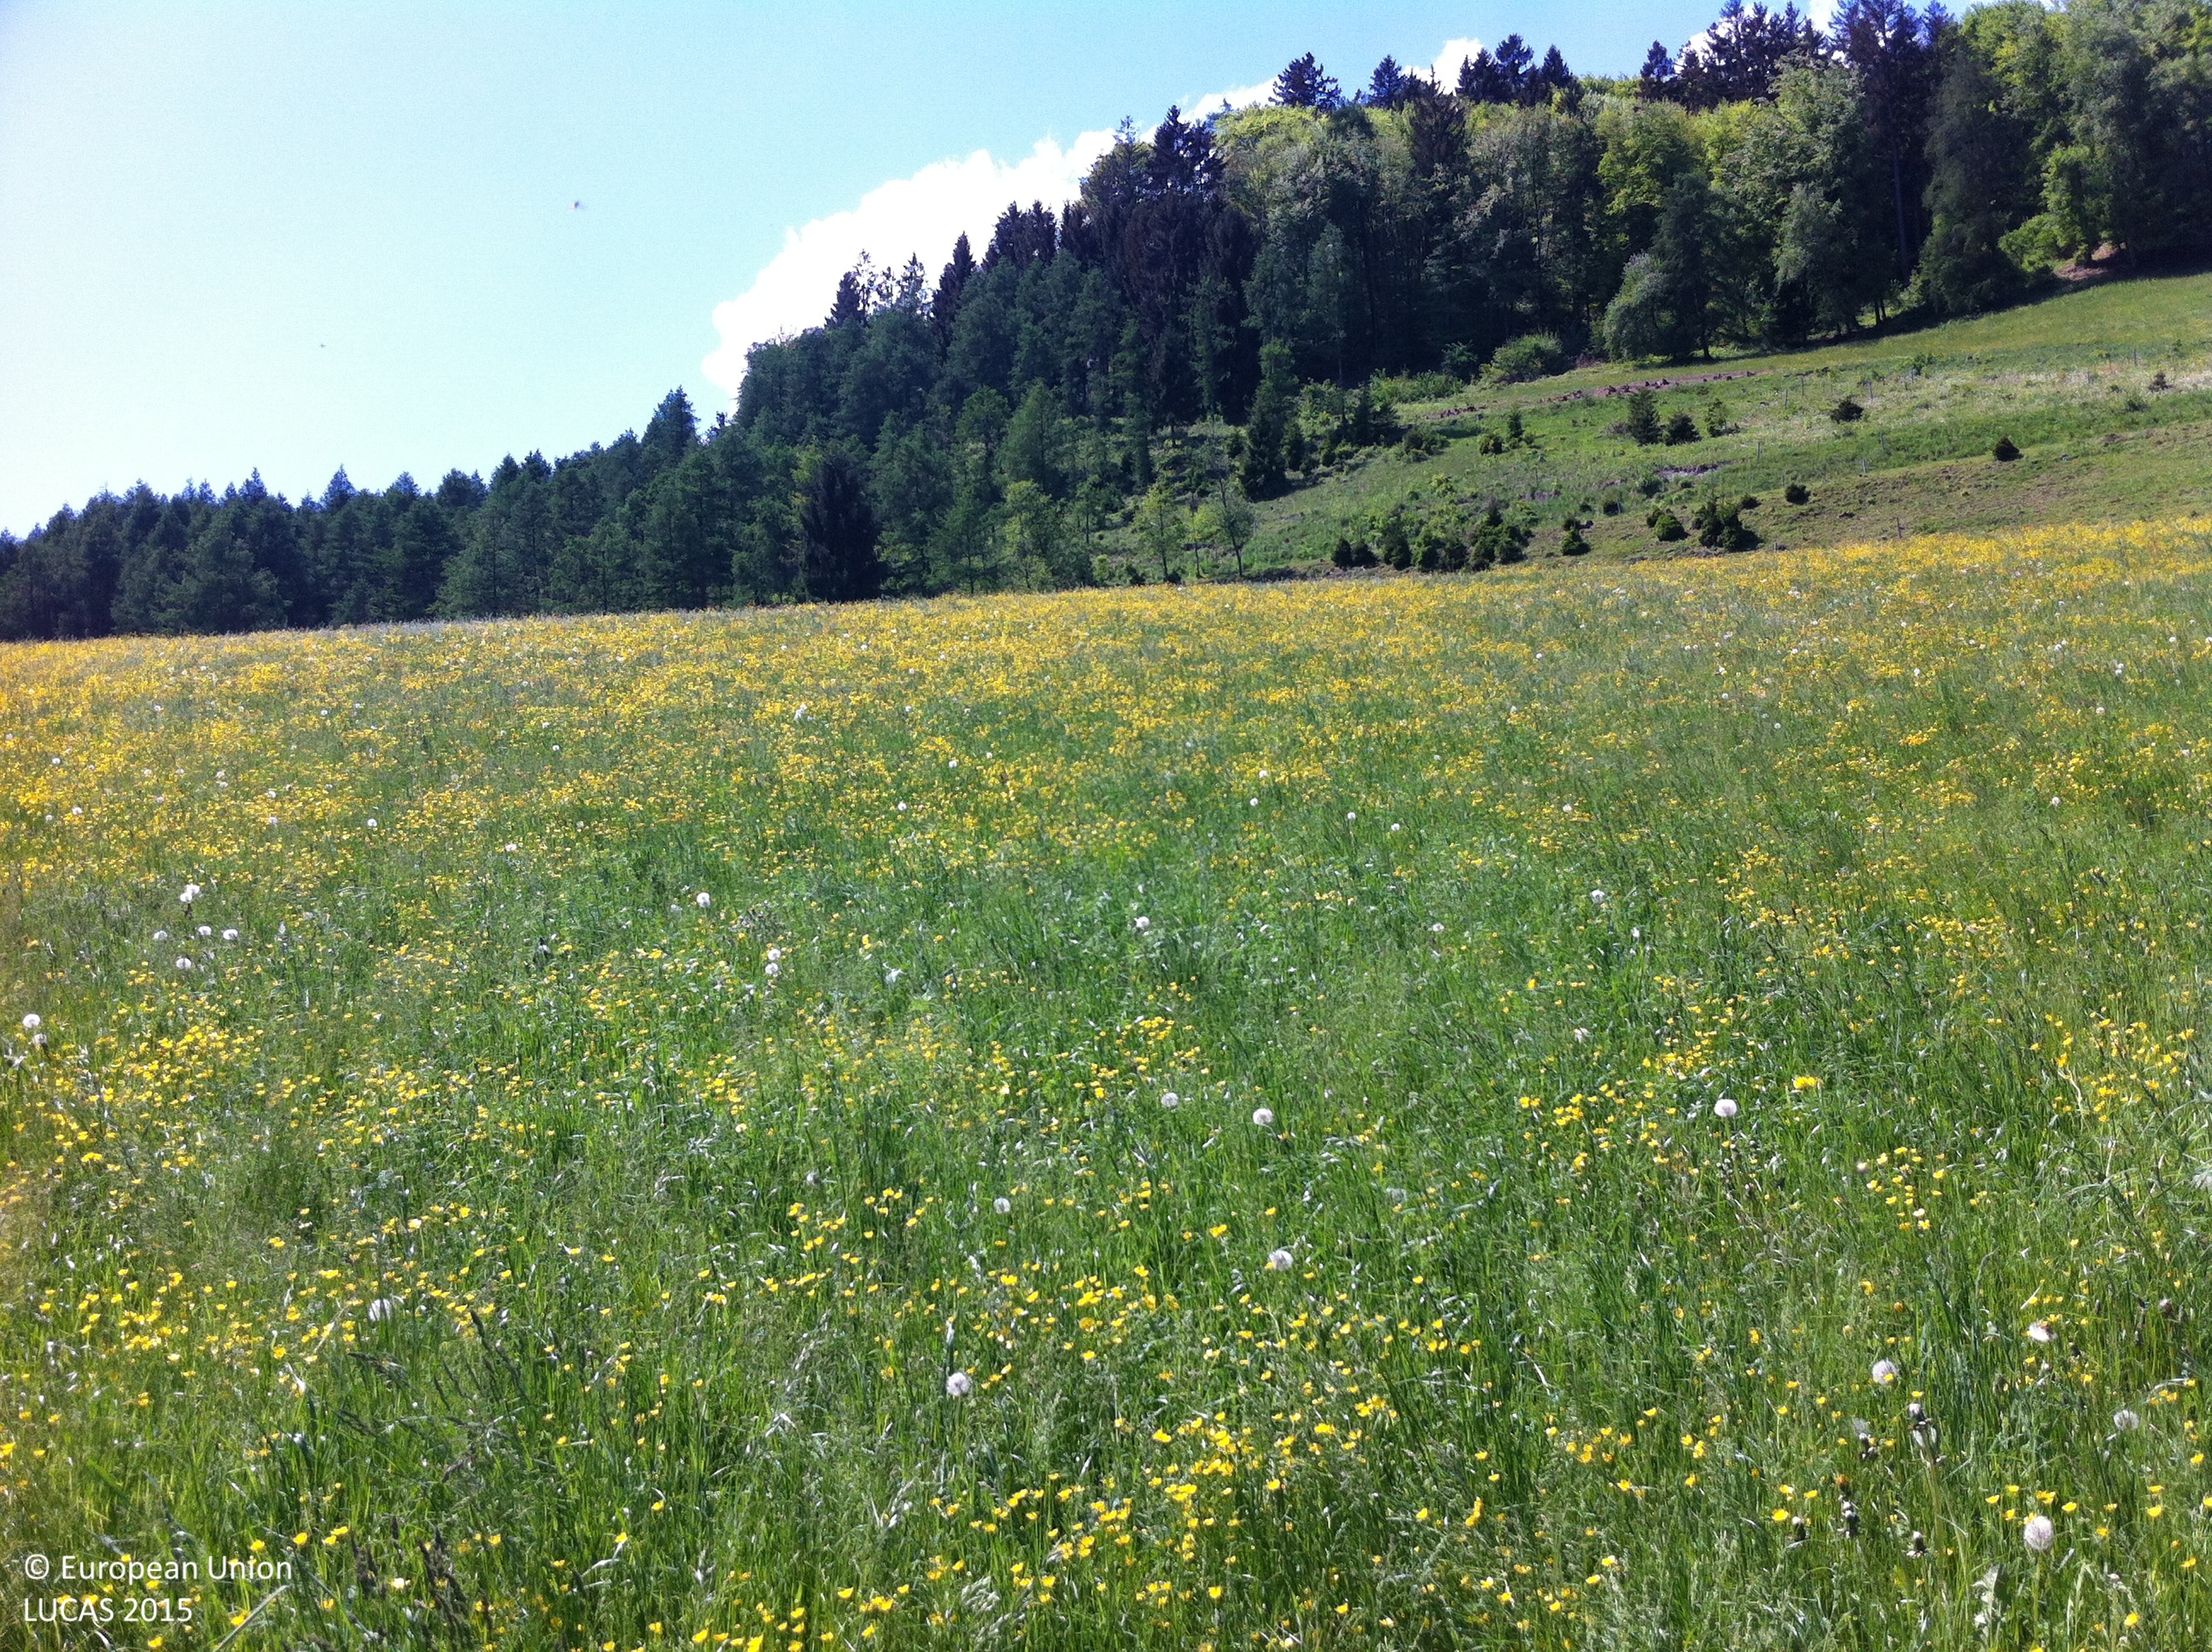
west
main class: Grassland
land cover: Grassland without tree/shrub cover
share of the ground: > 75 %
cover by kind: herbaceous plants 100 %
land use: Agriculture (excluding fallow land and kitchen gardens)
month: May
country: AT
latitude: 47.3989
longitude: 11.7873
